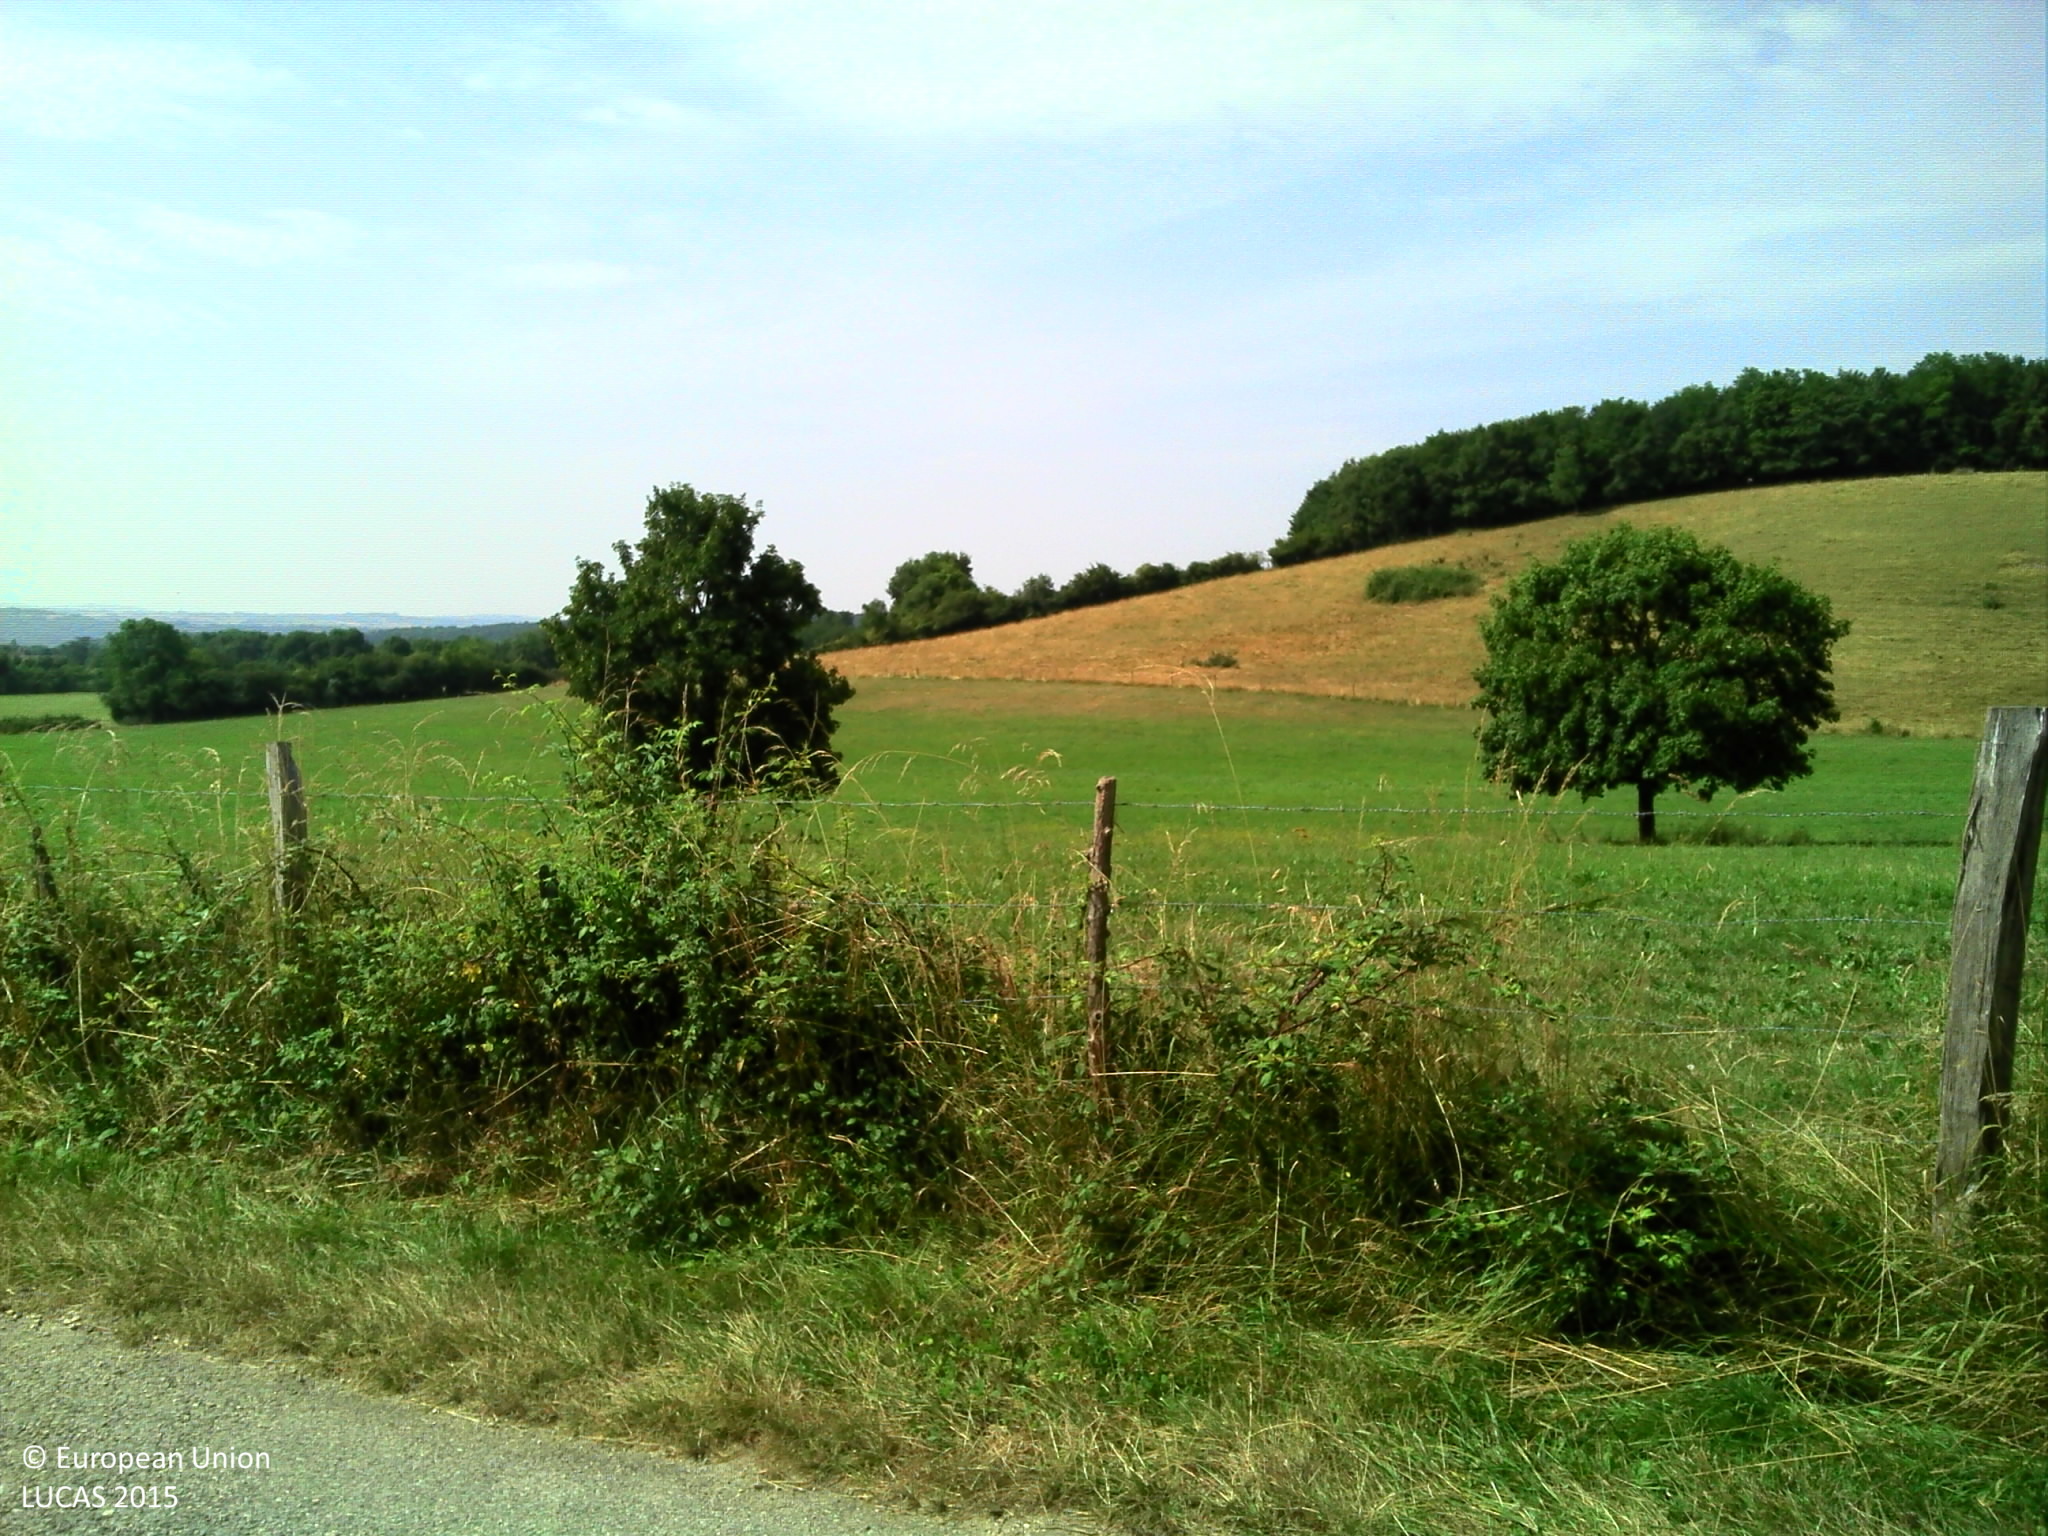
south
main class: Grassland
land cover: Grassland without tree/shrub cover
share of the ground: > 75 %
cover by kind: herbaceous plants 100 %
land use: Agriculture (excluding fallow land and kitchen gardens)
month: July
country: FR
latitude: 45.7275
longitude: 5.3654
